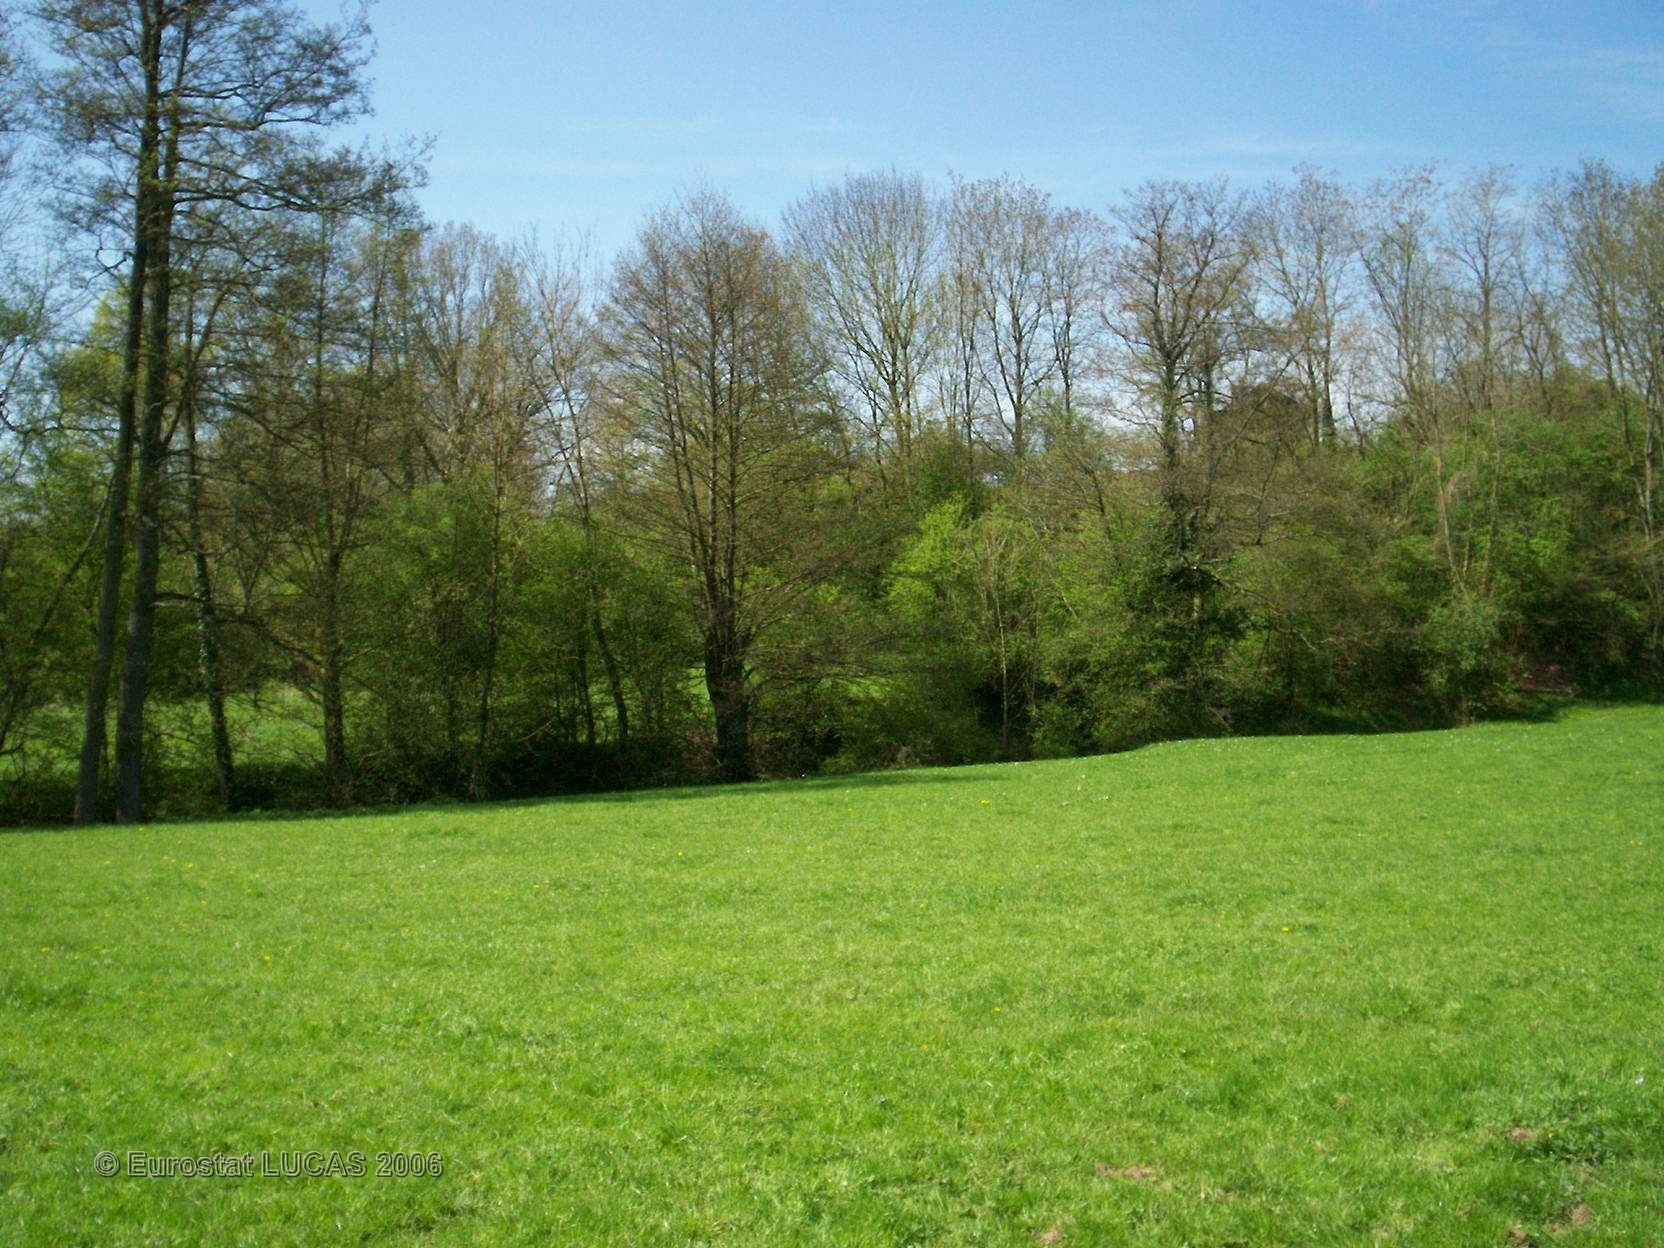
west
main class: Grassland
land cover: Grassland without tree/shrub cover
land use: Agriculture (excluding fallow land and kitchen gardens)
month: April
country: FR
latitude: 49.6466
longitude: 4.3312
